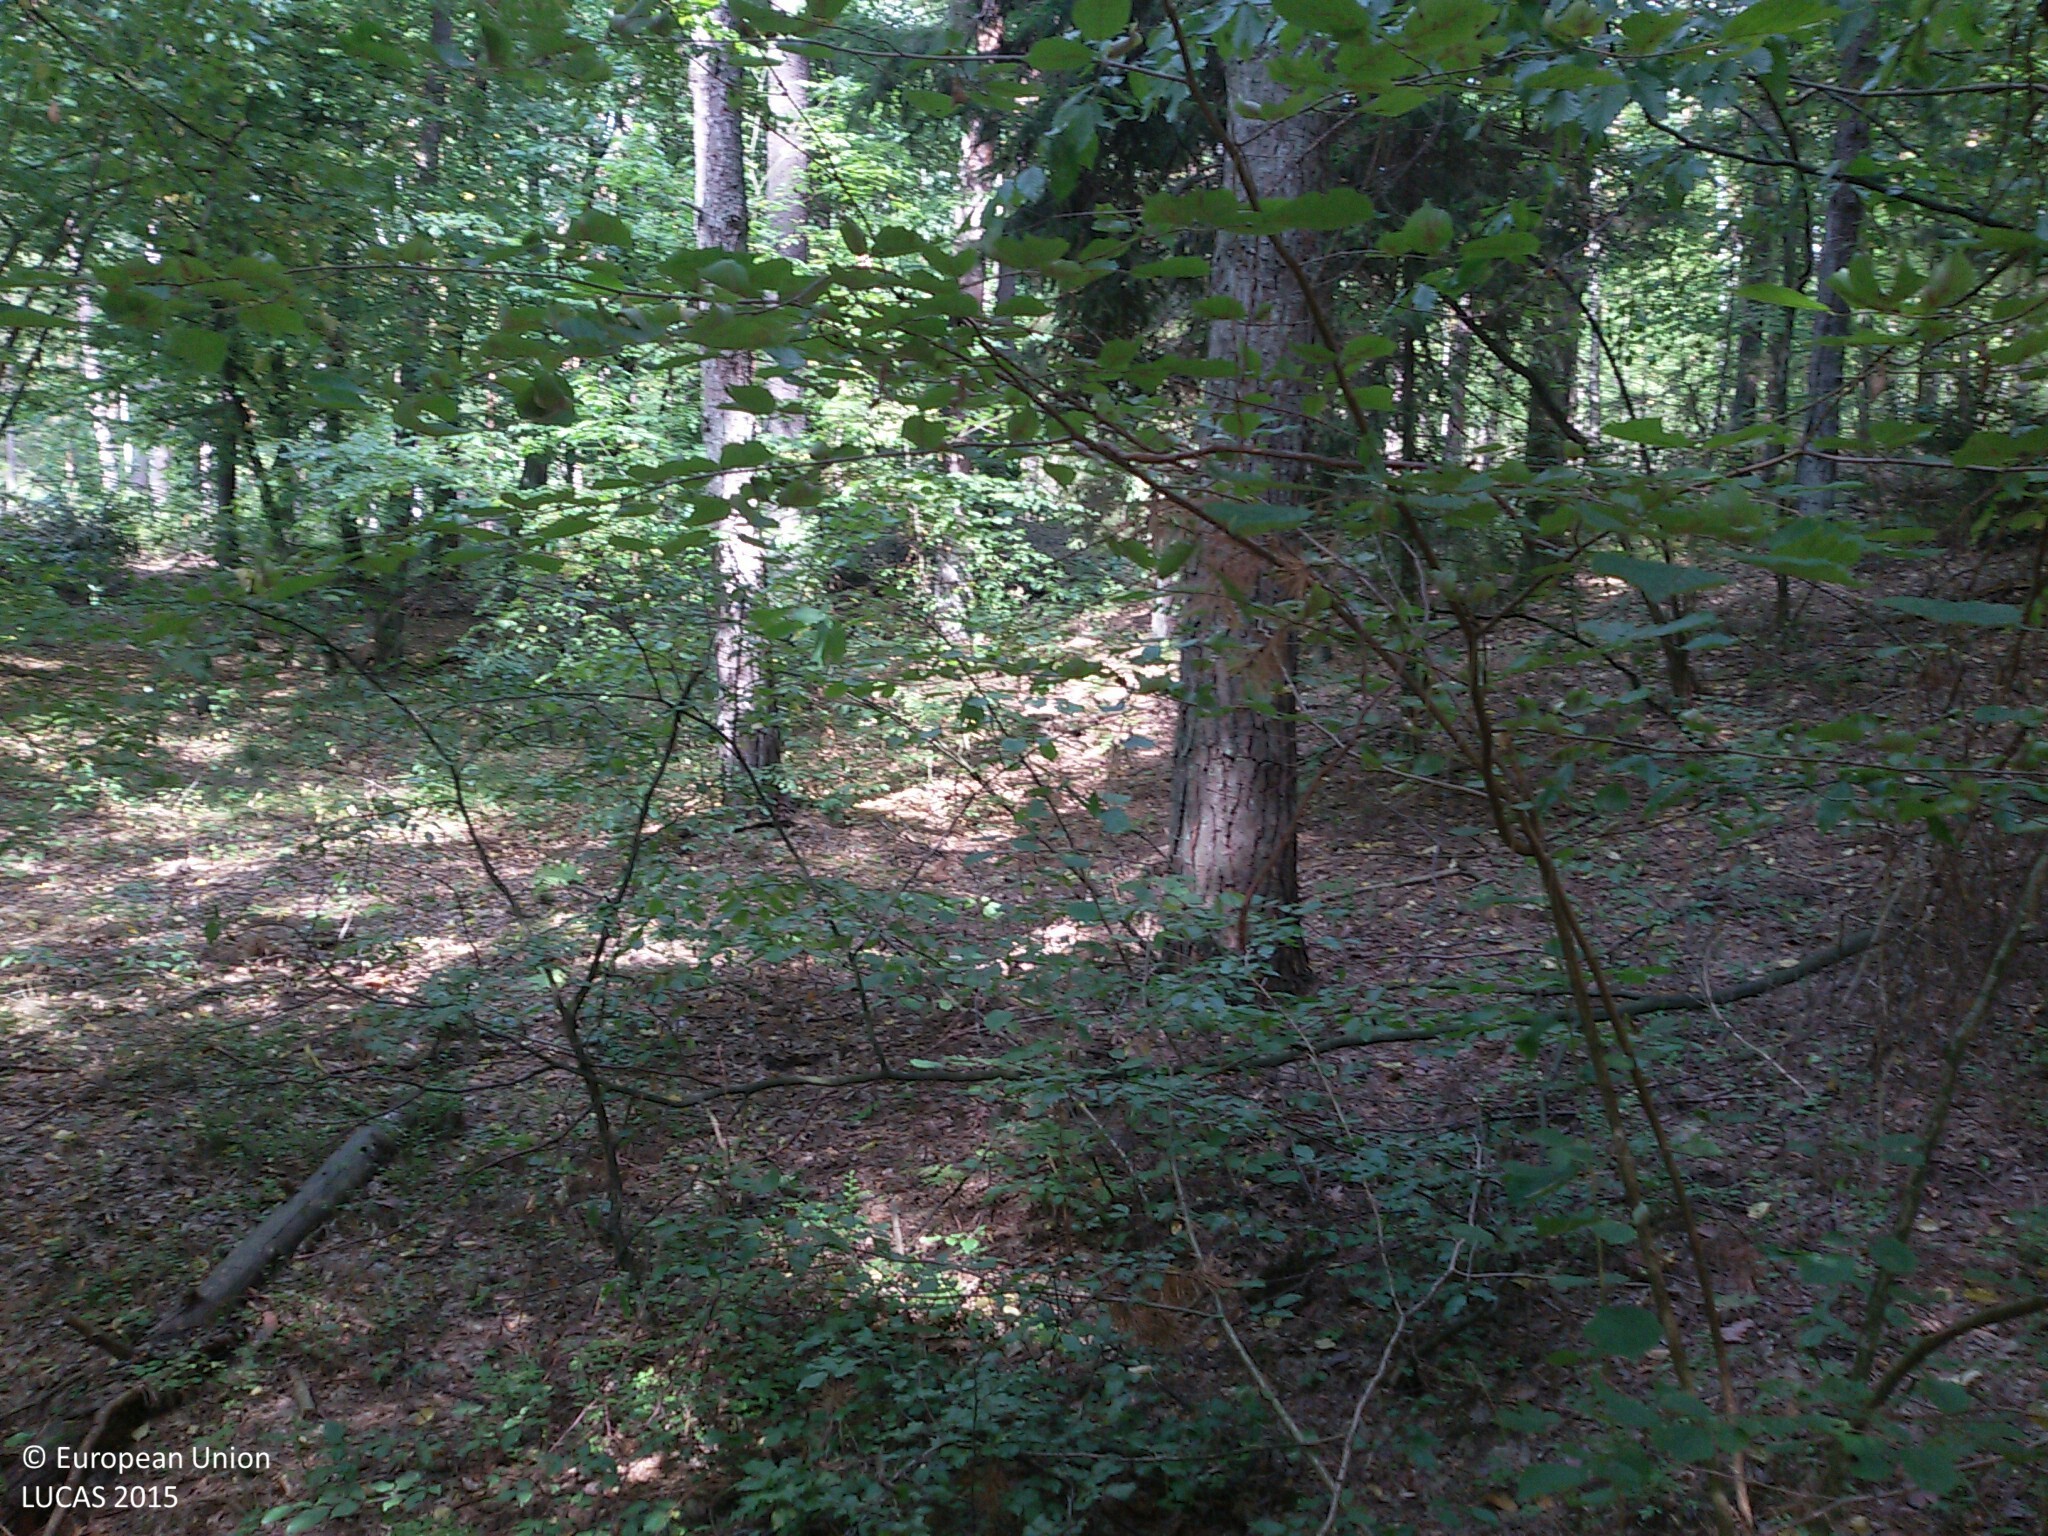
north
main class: Woodland
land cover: Pine dominated mixed woodland
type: hemiboreal forest and nemoral coniferous forest and mixed broadleaved-coniferous forest
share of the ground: > 75 %
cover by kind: coniferous forest trees 65 %, broadleaved forest trees 25 %, herbaceous plants 5 %, unconsolidated bare surface 5 %
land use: Forestry
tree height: > 5 m
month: August
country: PL
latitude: 53.5712
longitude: 20.1660
